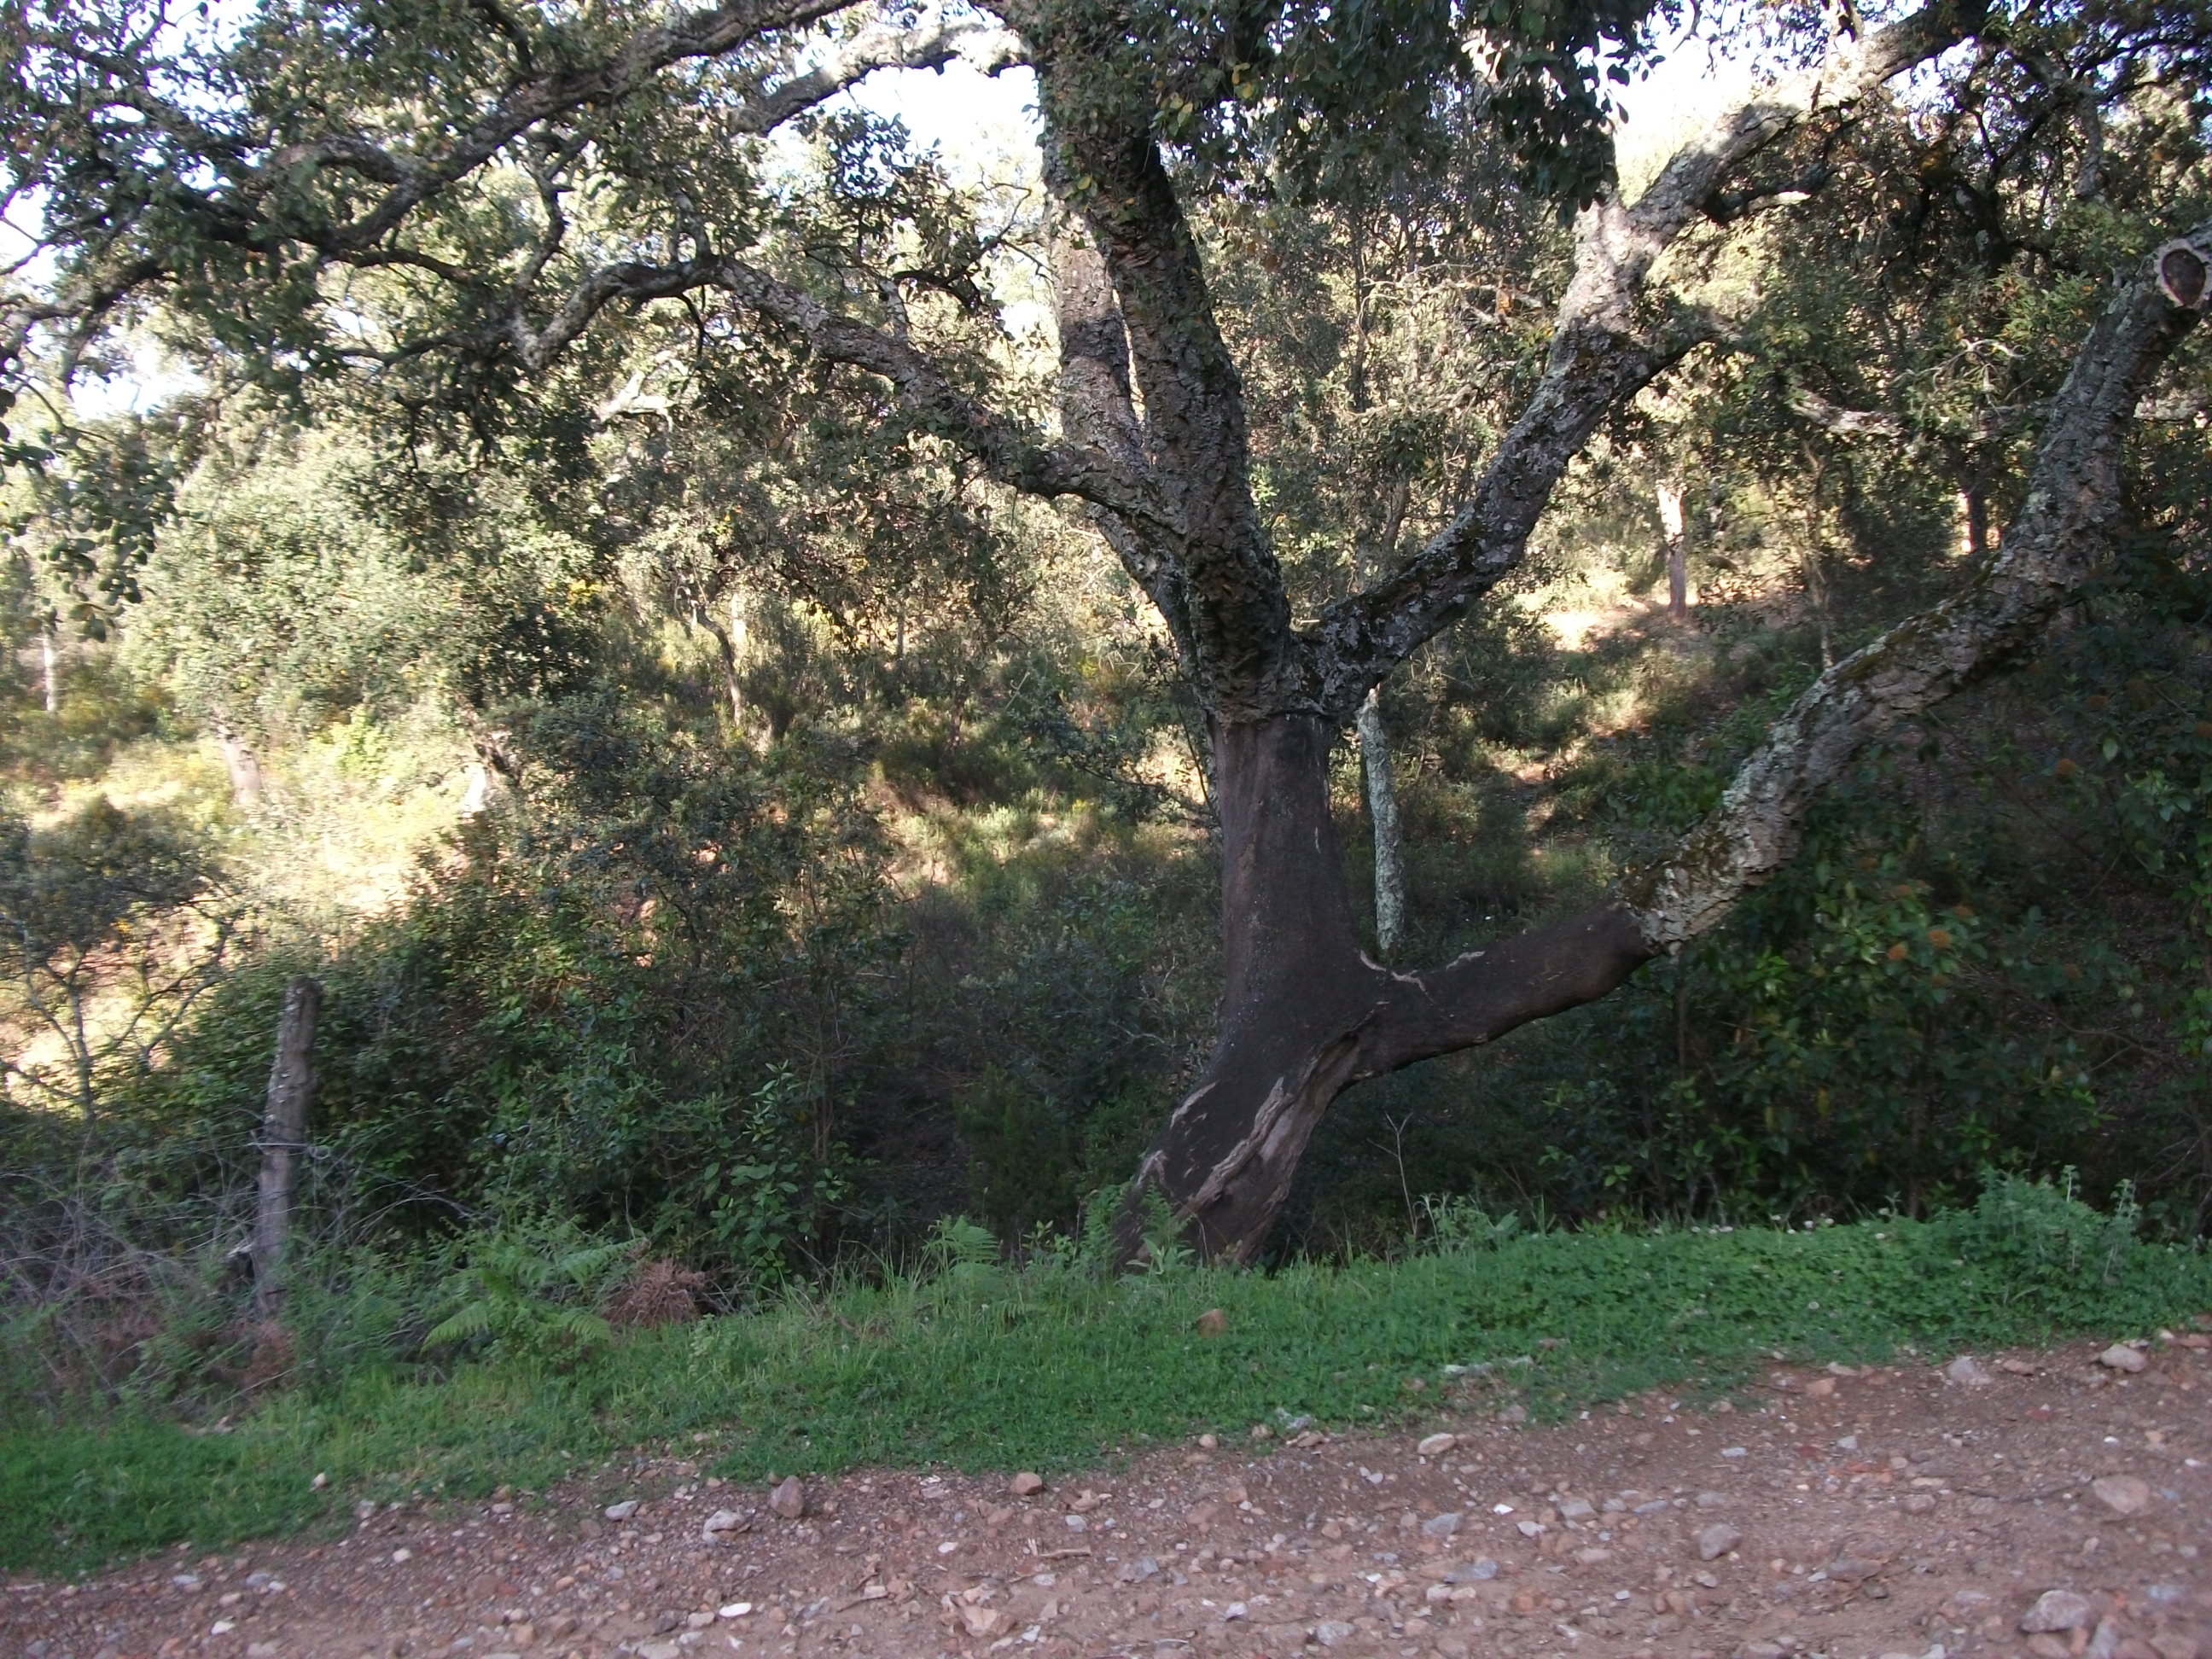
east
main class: Woodland
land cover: Broadleaved woodland
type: broadleaved evergreen forest
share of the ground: 50 - 75 %
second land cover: Grassland without tree/shrub cover
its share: > 75 %
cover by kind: broadleaved forest trees 70 %, herbaceous plants 30 %
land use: Forestry
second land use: Agriculture (excluding fallow land and kitchen gardens)
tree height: > 5 m
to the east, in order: Broadleaved woodland; Grassland without tree/shrub cover; Rock outcrops; Nuts trees; Fences; Grass margins; Ditches and canals; Tracks; Broadleaved woodland; Rivers and streams; Broadleaved woodland; Fences; Broadleaved woodland
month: April
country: ES
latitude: 37.8619
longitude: -6.7207
